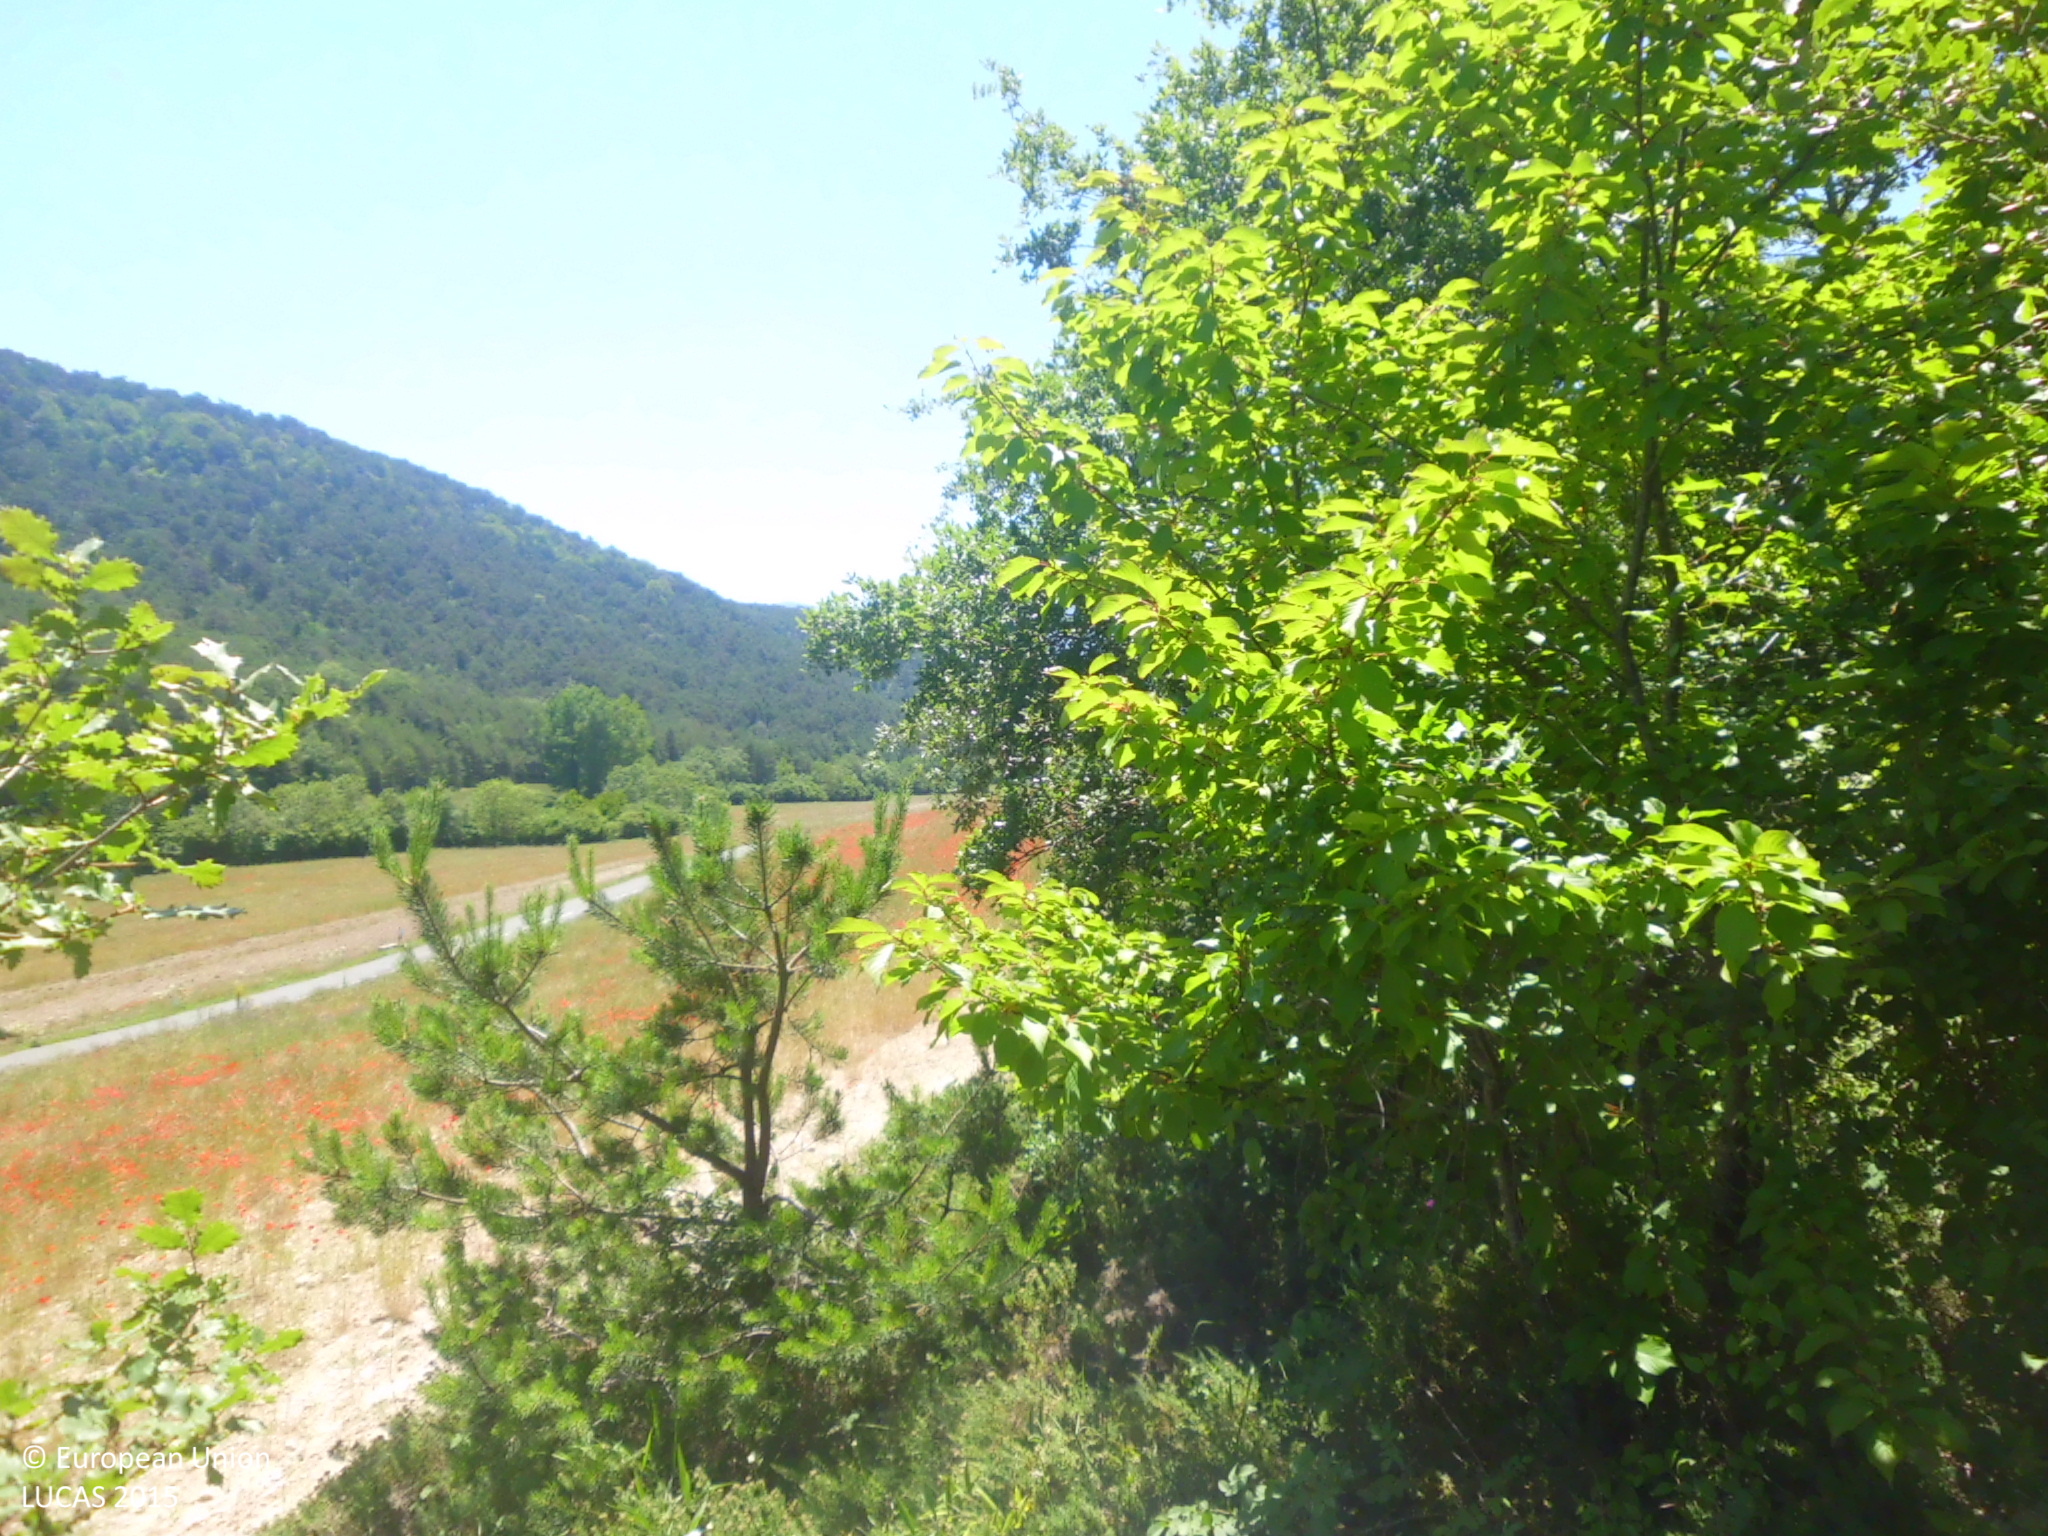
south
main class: Woodland
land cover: Broadleaved woodland
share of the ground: 25 - 50 %
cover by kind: herbaceous plants 50 %, broadleaved forest trees 35 %, shrubs 15 %
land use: Semi-natural and natural areas not in use
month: June
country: ES
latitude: 42.8890
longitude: -3.1477
